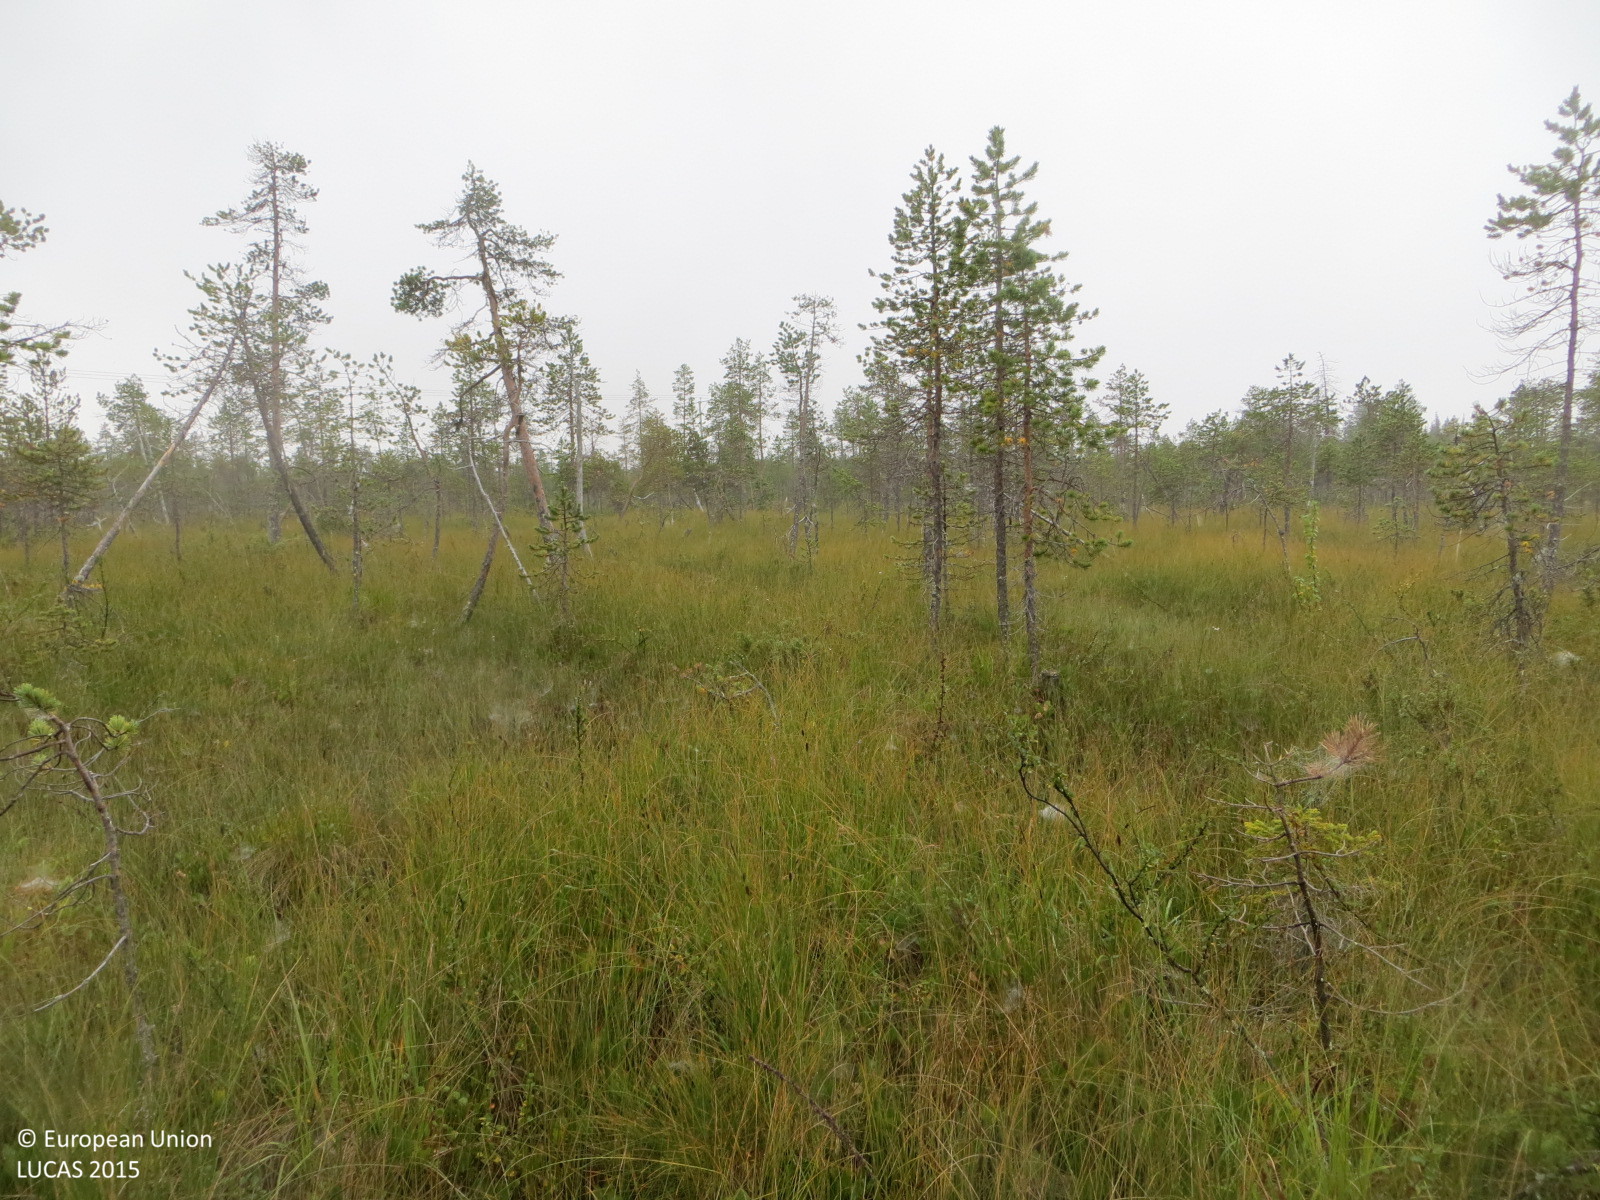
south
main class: Woodland
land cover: Pine dominated coniferous woodland
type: mire and swamp forests
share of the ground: 10 - 25 %
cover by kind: herbaceous plants 70 %, coniferous forest trees 15 %, shrubs 15 %
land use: Semi-natural and natural areas not in use
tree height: > 5 m
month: August
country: FI
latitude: 67.3712
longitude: 23.9752
